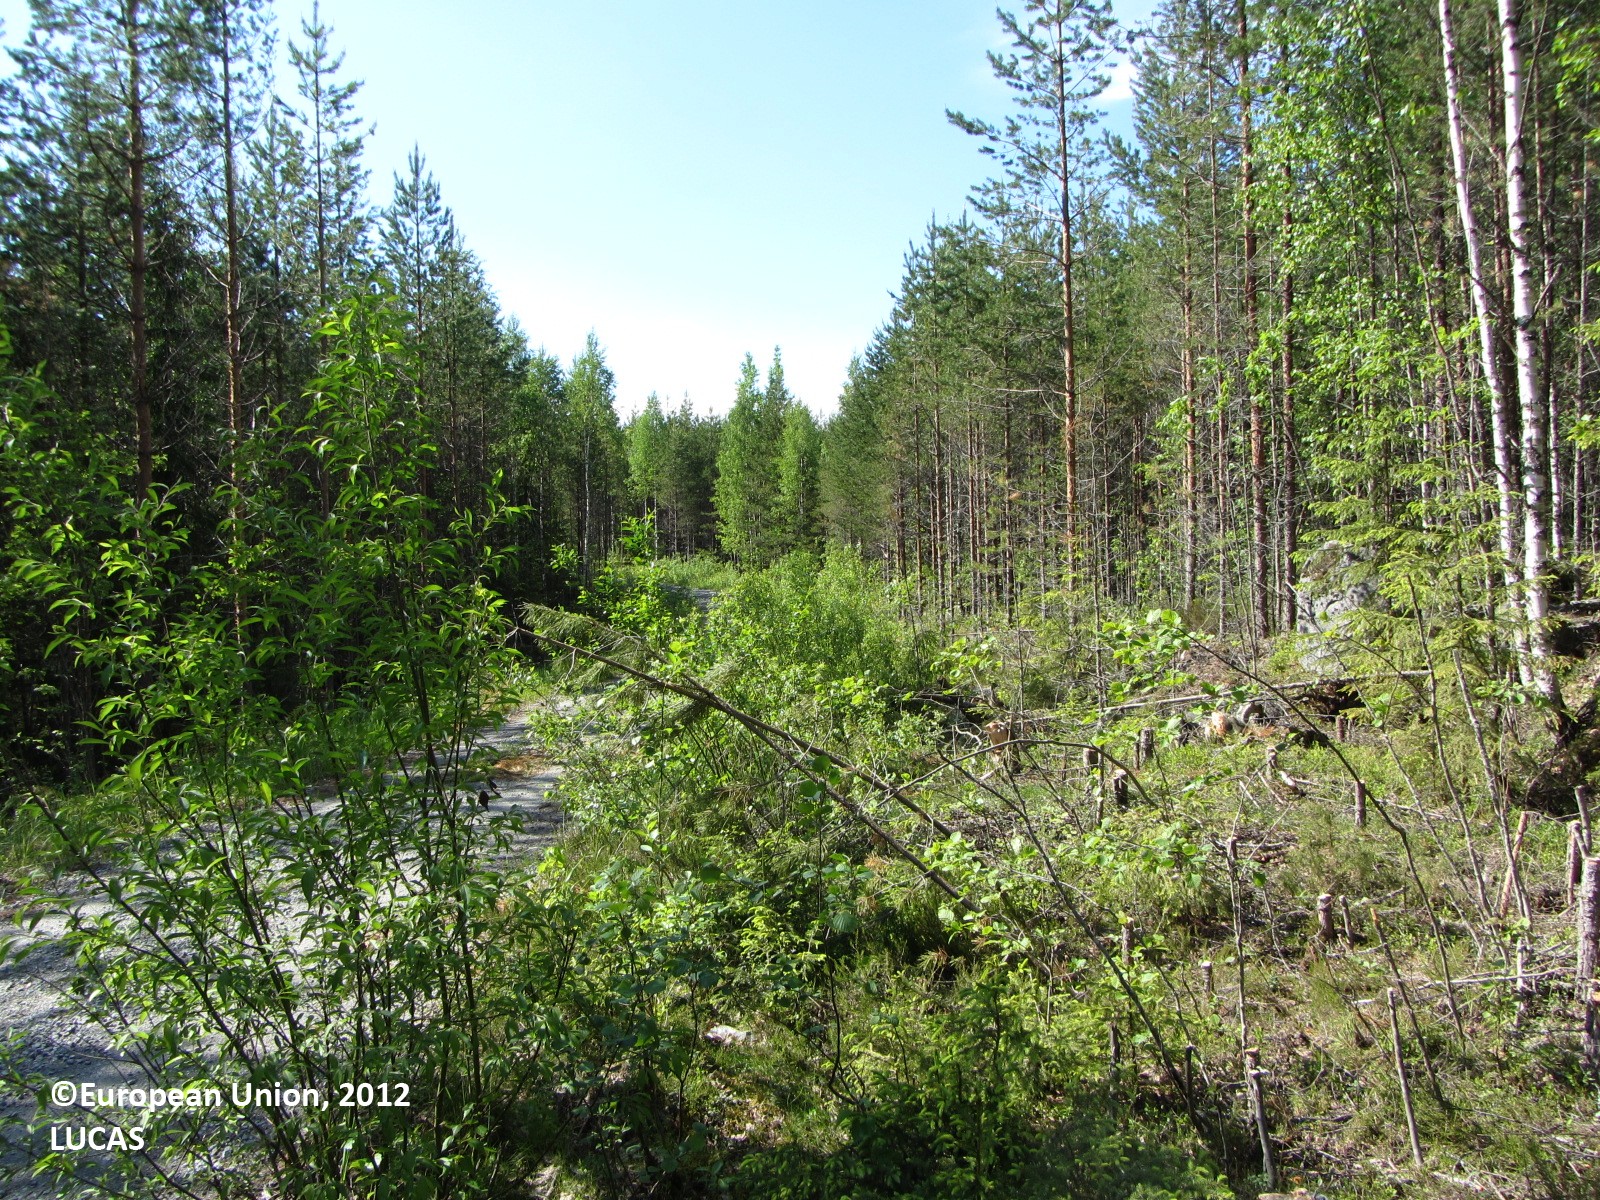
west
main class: Woodland
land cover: Other mixed woodland
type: boreal forest
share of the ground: > 75 %
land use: Forestry
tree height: > 5 m
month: June
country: FI
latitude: 62.3112
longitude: 24.8564
